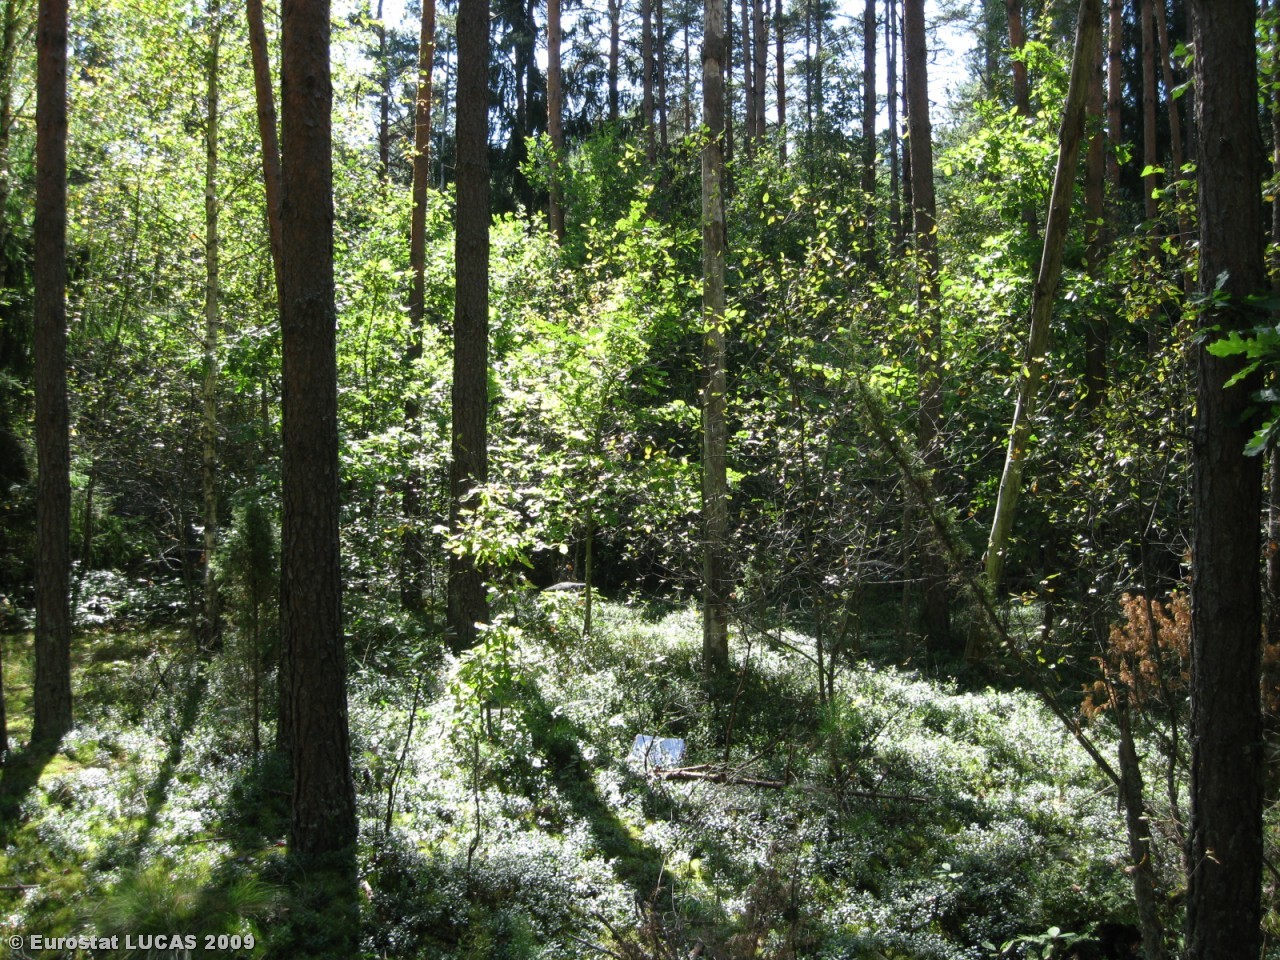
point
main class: Woodland
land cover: Mixed woodland
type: hemiboreal forest and nemoral coniferous forest and mixed broadleaved-coniferous forest
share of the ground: > 75 %
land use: Forestry
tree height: > 5 m
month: August
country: LT
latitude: 54.3173
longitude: 24.6338
